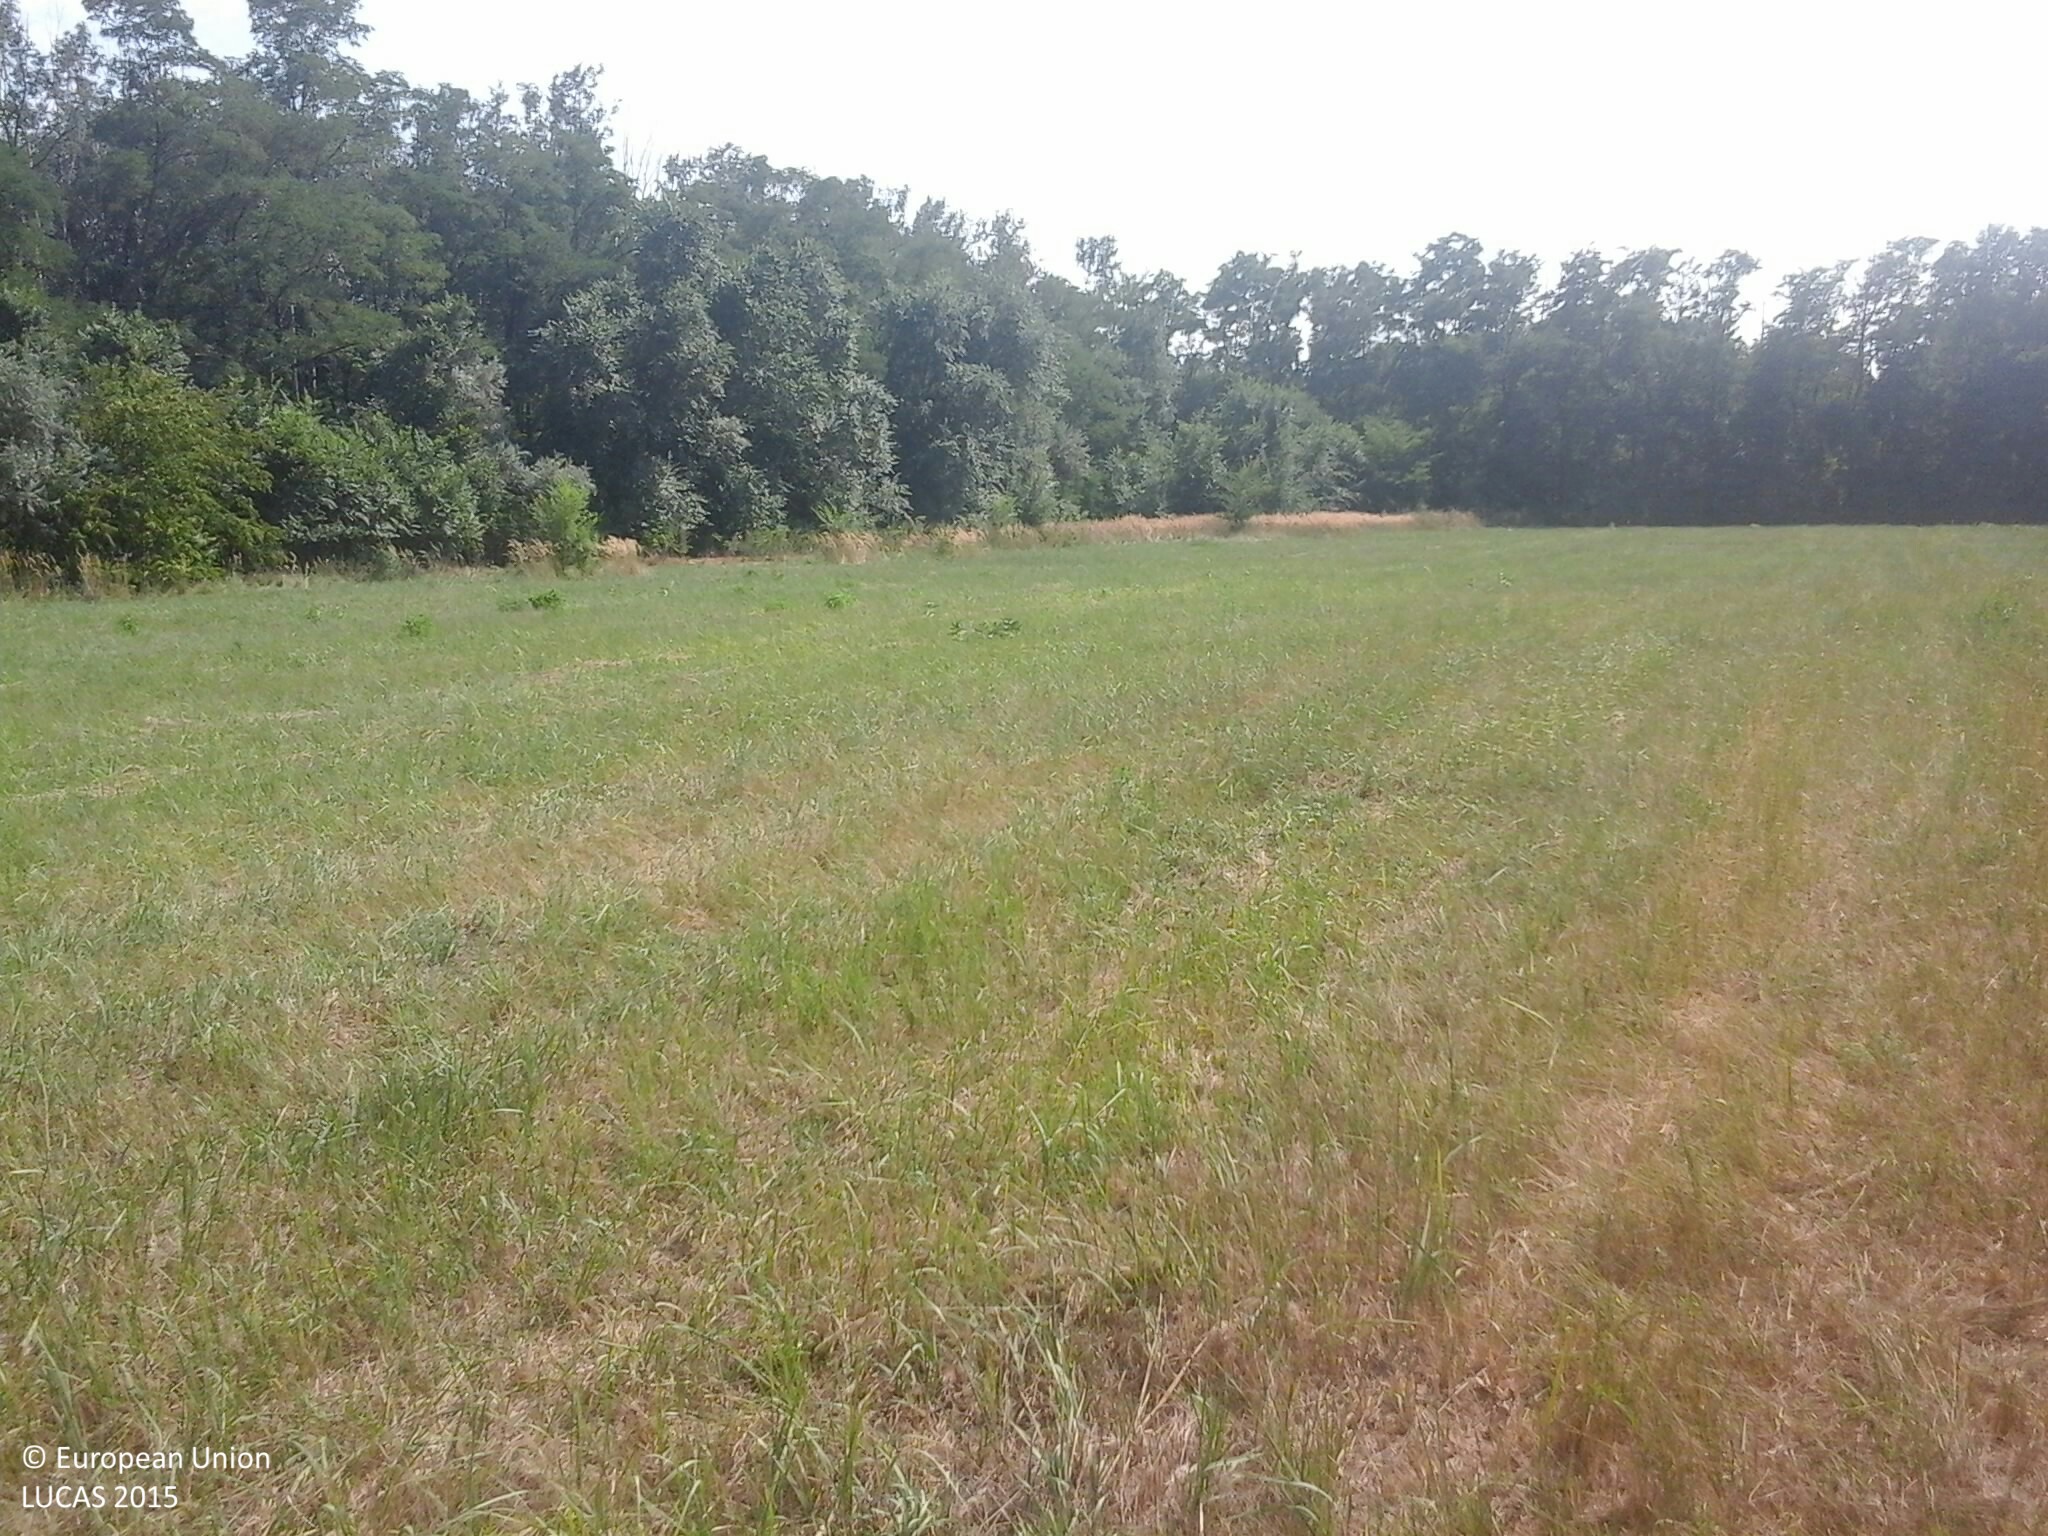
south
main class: Grassland
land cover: Grassland without tree/shrub cover
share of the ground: > 75 %
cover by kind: herbaceous plants 100 %
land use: Agriculture (excluding fallow land and kitchen gardens)
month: August
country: HU
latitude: 47.4144
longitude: 19.2837
